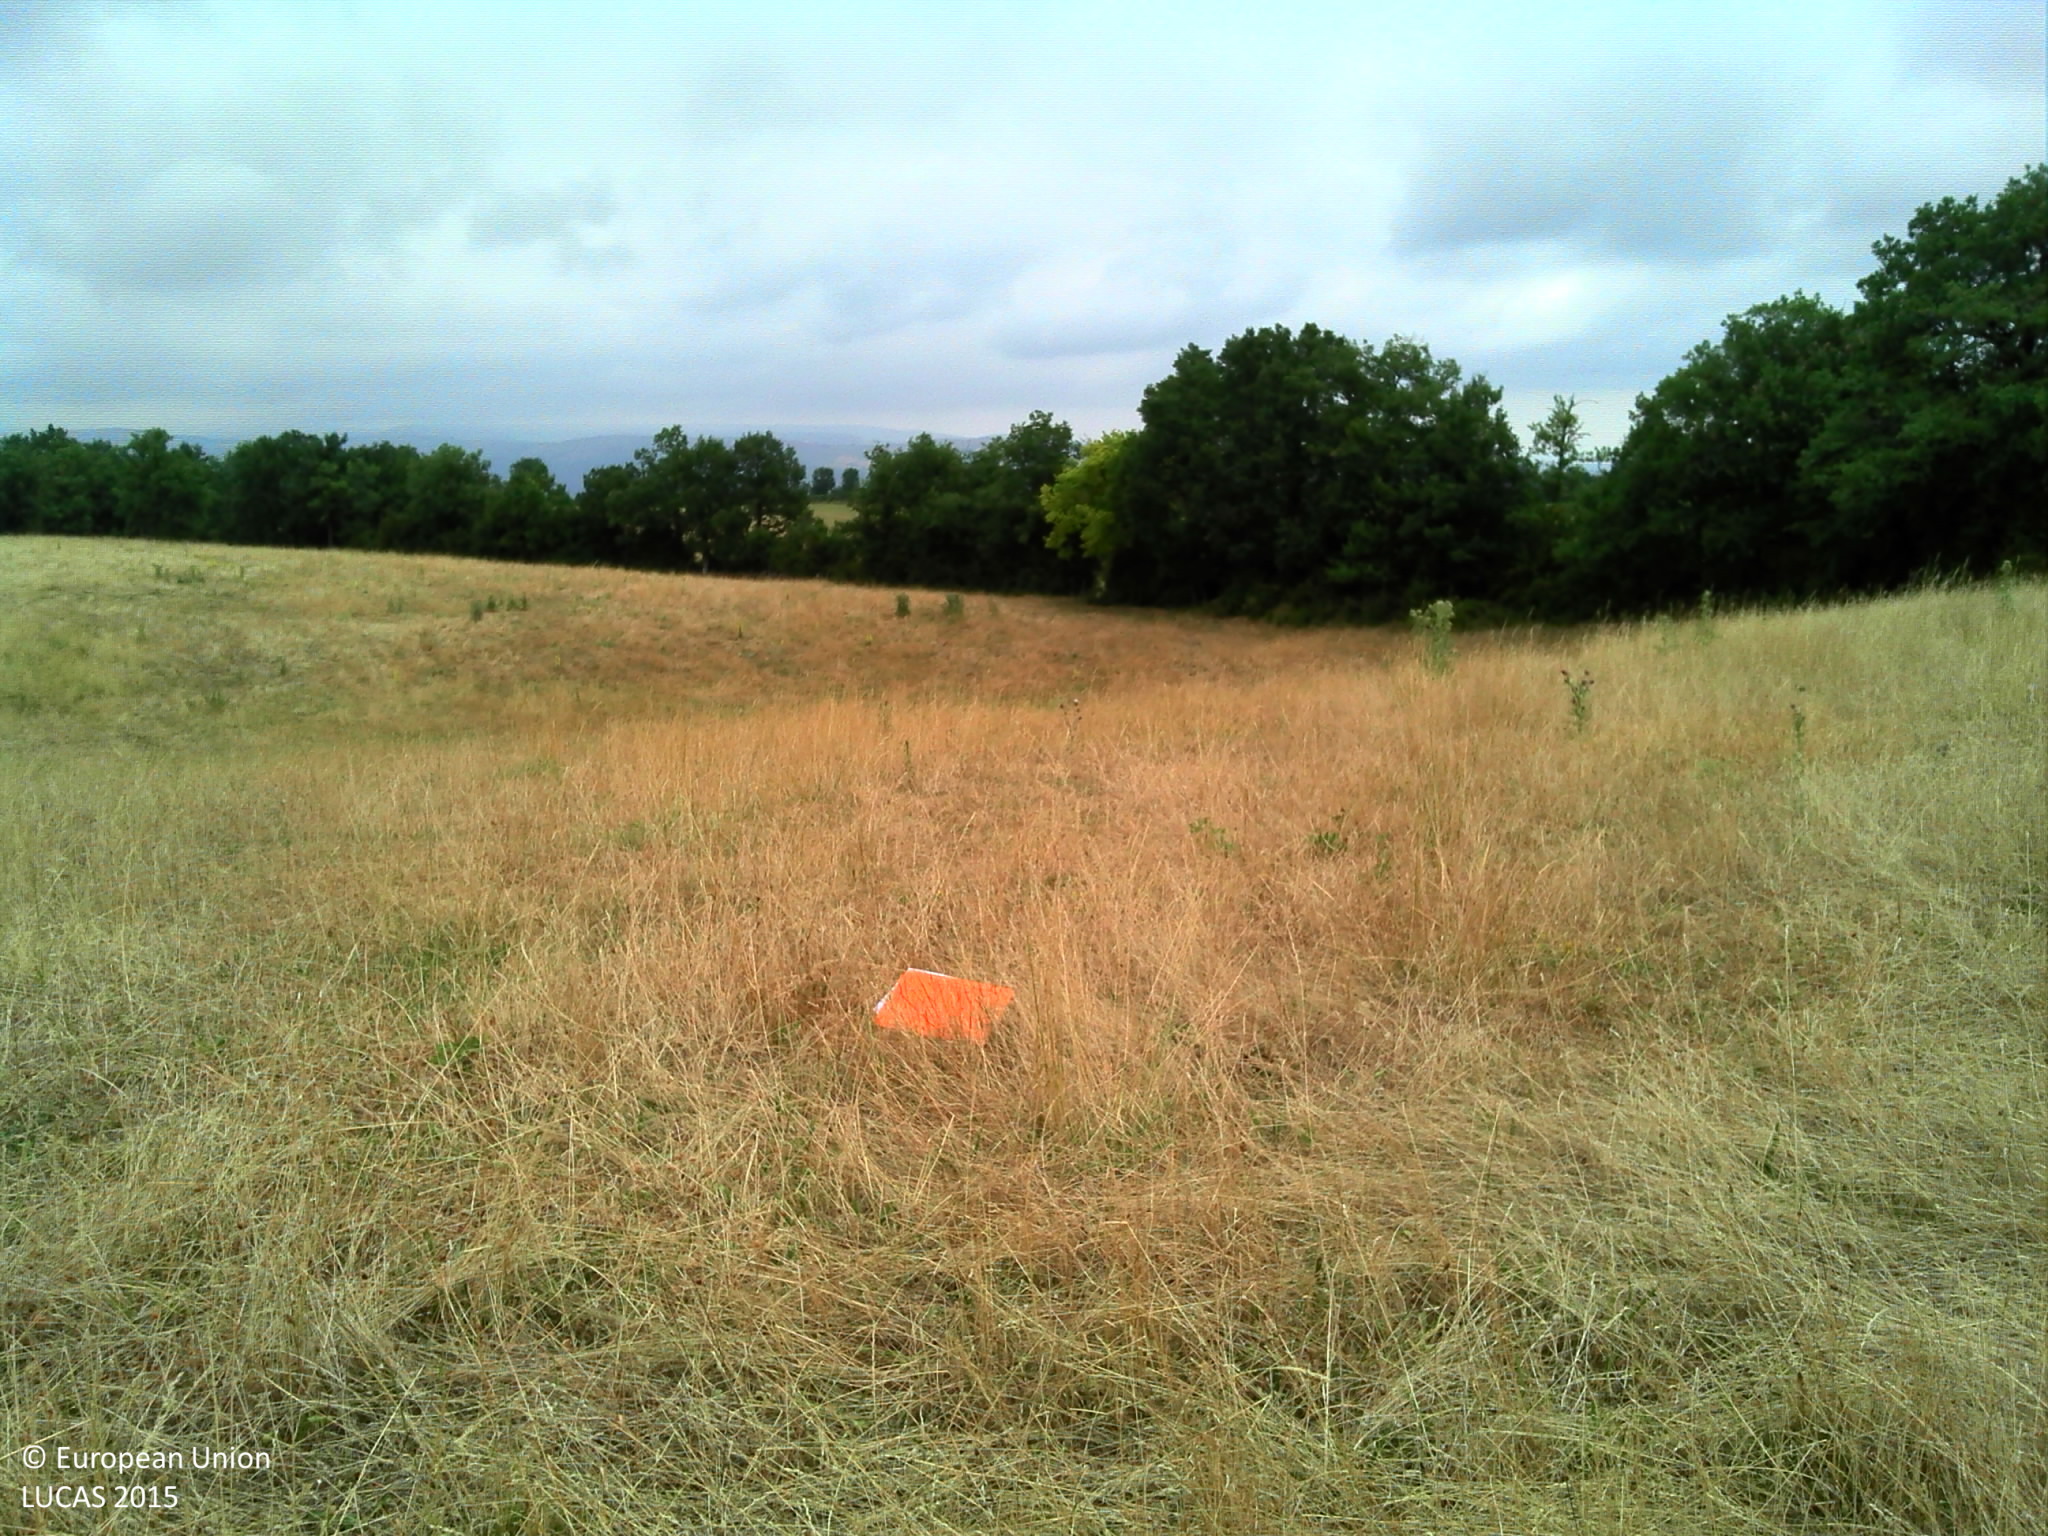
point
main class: Grassland
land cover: Grassland without tree/shrub cover
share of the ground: > 75 %
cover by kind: herbaceous plants 95 %, shrubs 5 %
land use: Agriculture (excluding fallow land and kitchen gardens)
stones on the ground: 25 - 50 %
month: July
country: FR
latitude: 44.4076
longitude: 3.0605
